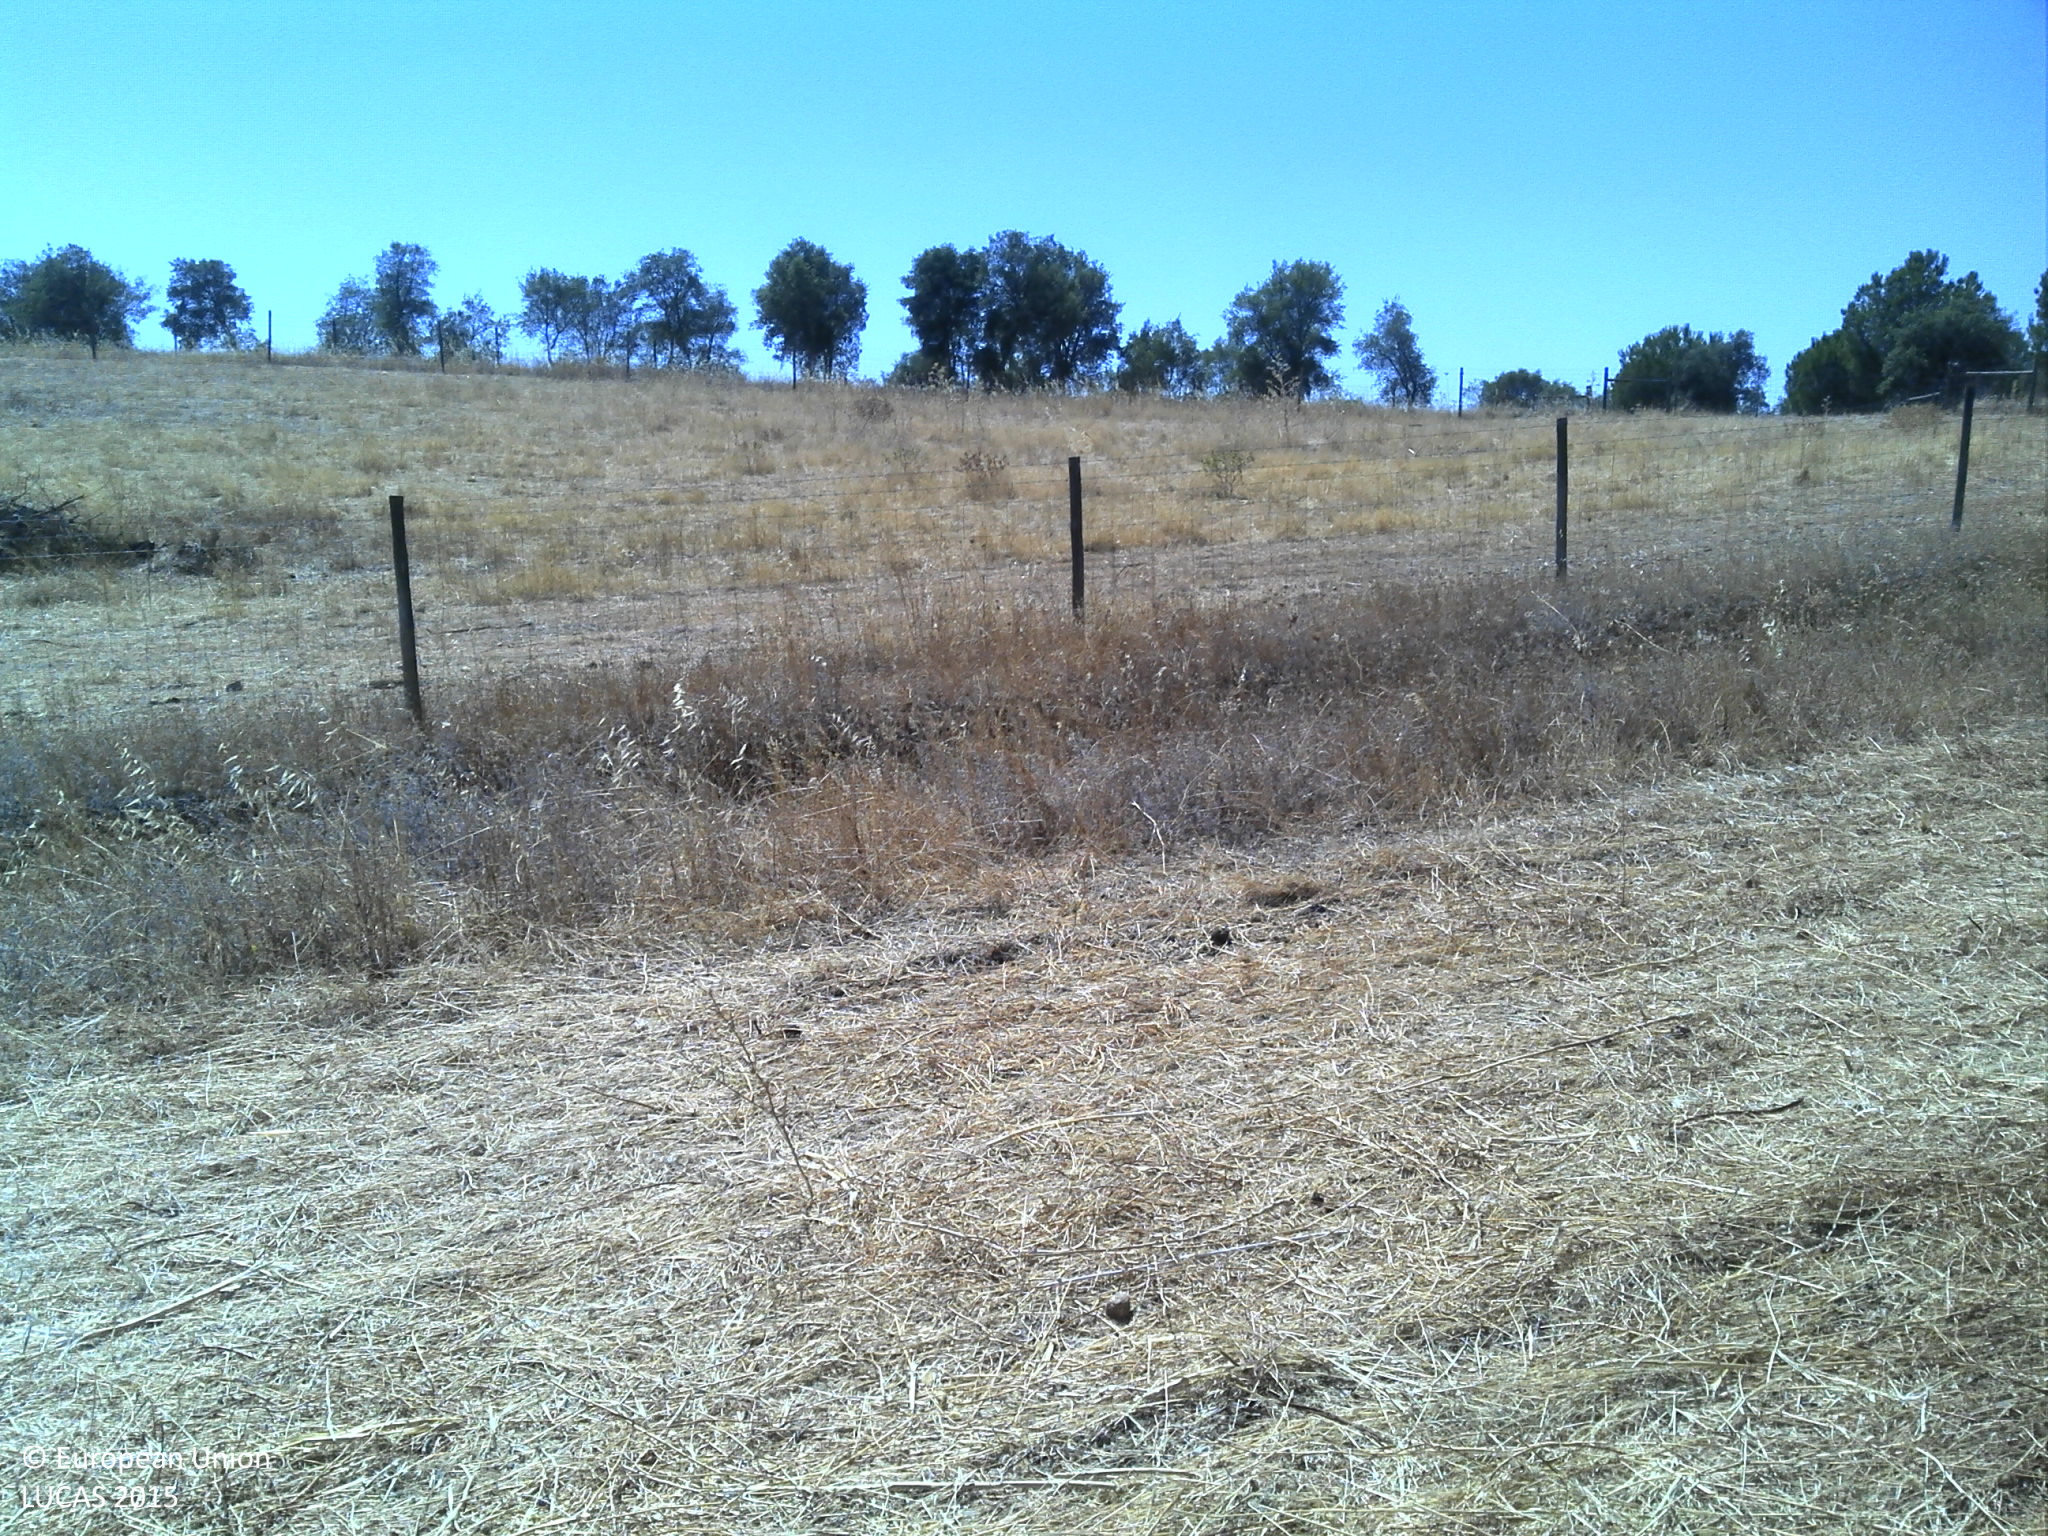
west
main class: Grassland
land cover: Grassland without tree/shrub cover
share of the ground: > 75 %
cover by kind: herbaceous plants 85 %, unconsolidated bare surface 15 %
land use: Agriculture (excluding fallow land and kitchen gardens)
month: July
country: PT
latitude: 38.1577
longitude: -7.7281
